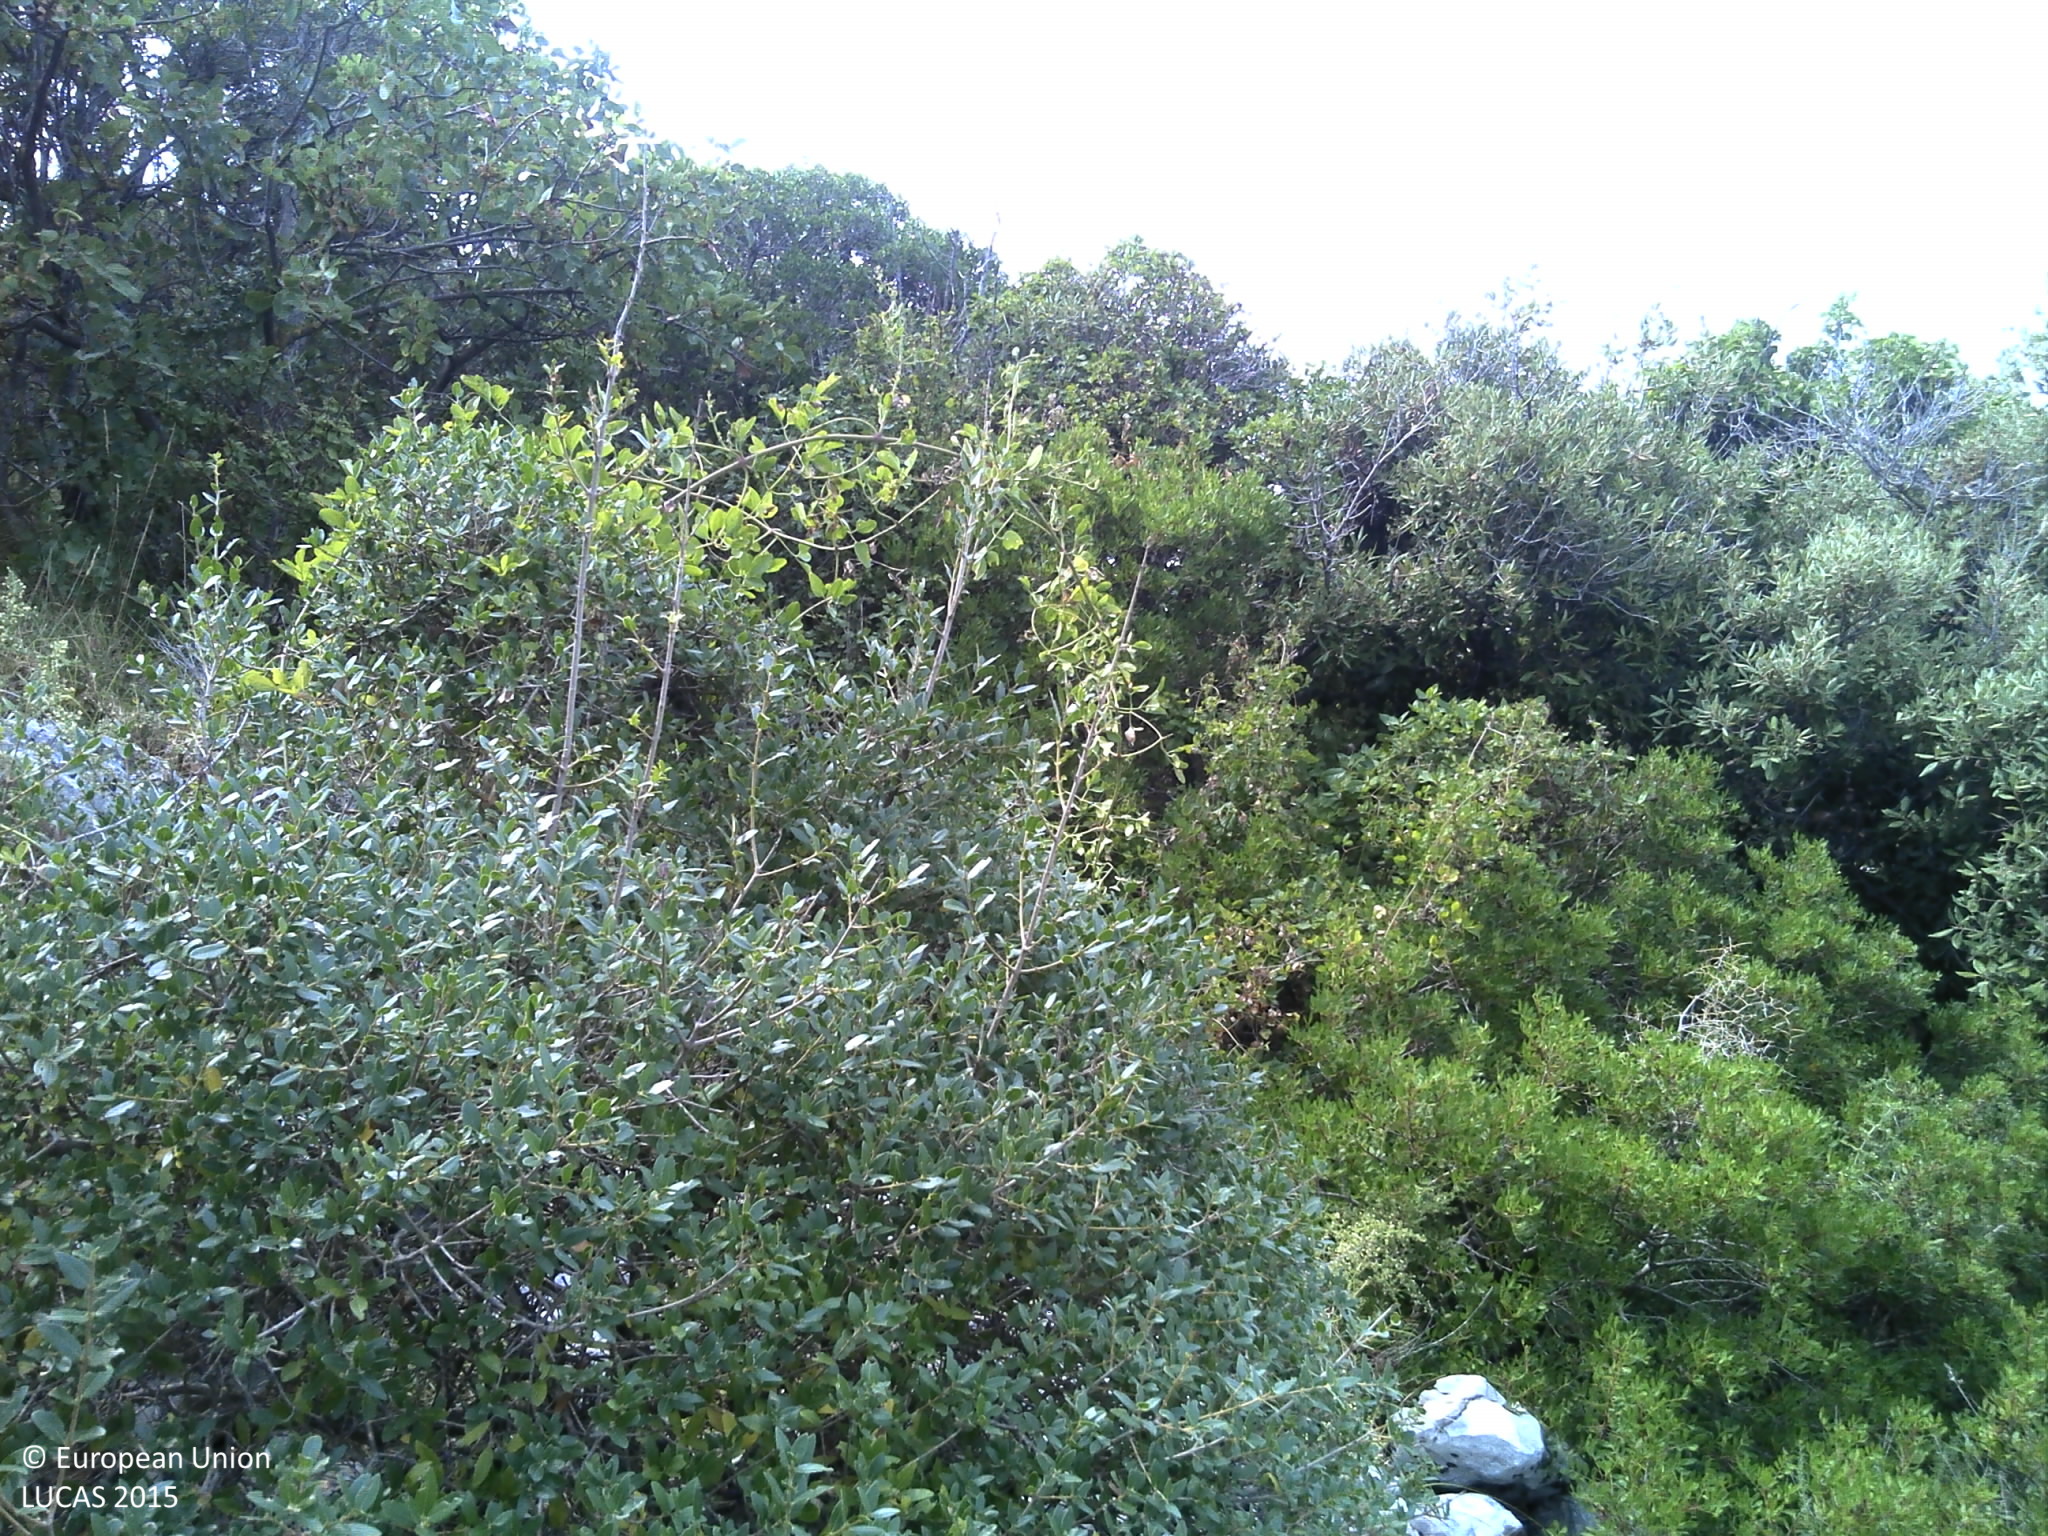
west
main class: Shrubland
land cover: Shrubland with sparse tree cover
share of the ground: > 75 %
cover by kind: shrubs 80 %, consolidated bare surface 10 %, broadleaved forest trees 5 %, herbaceous plants 5 %
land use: Semi-natural and natural areas not in use
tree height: < 5 m
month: September
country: HR
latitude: 44.1154
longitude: 15.1274
